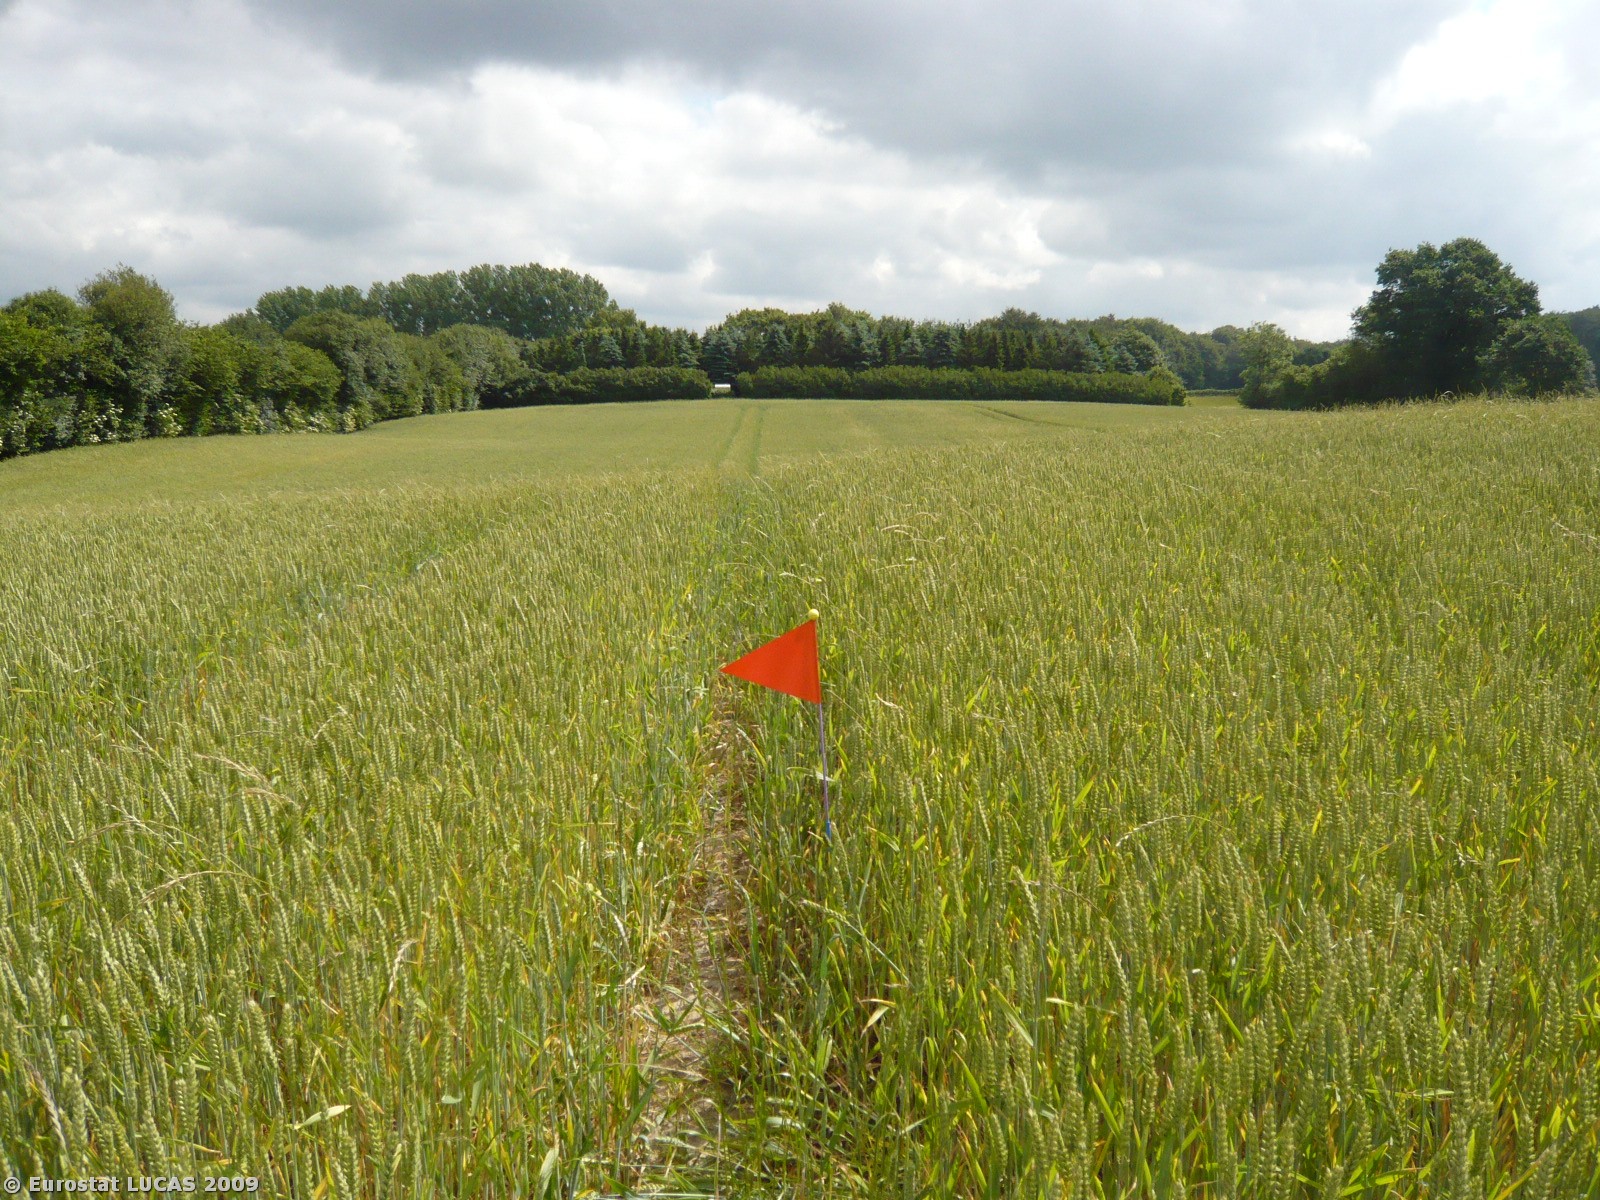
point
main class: Cropland
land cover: Common wheat
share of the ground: > 75 %
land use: Agriculture (excluding fallow land and kitchen gardens)
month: June
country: DK
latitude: 55.2709
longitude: 10.1730
